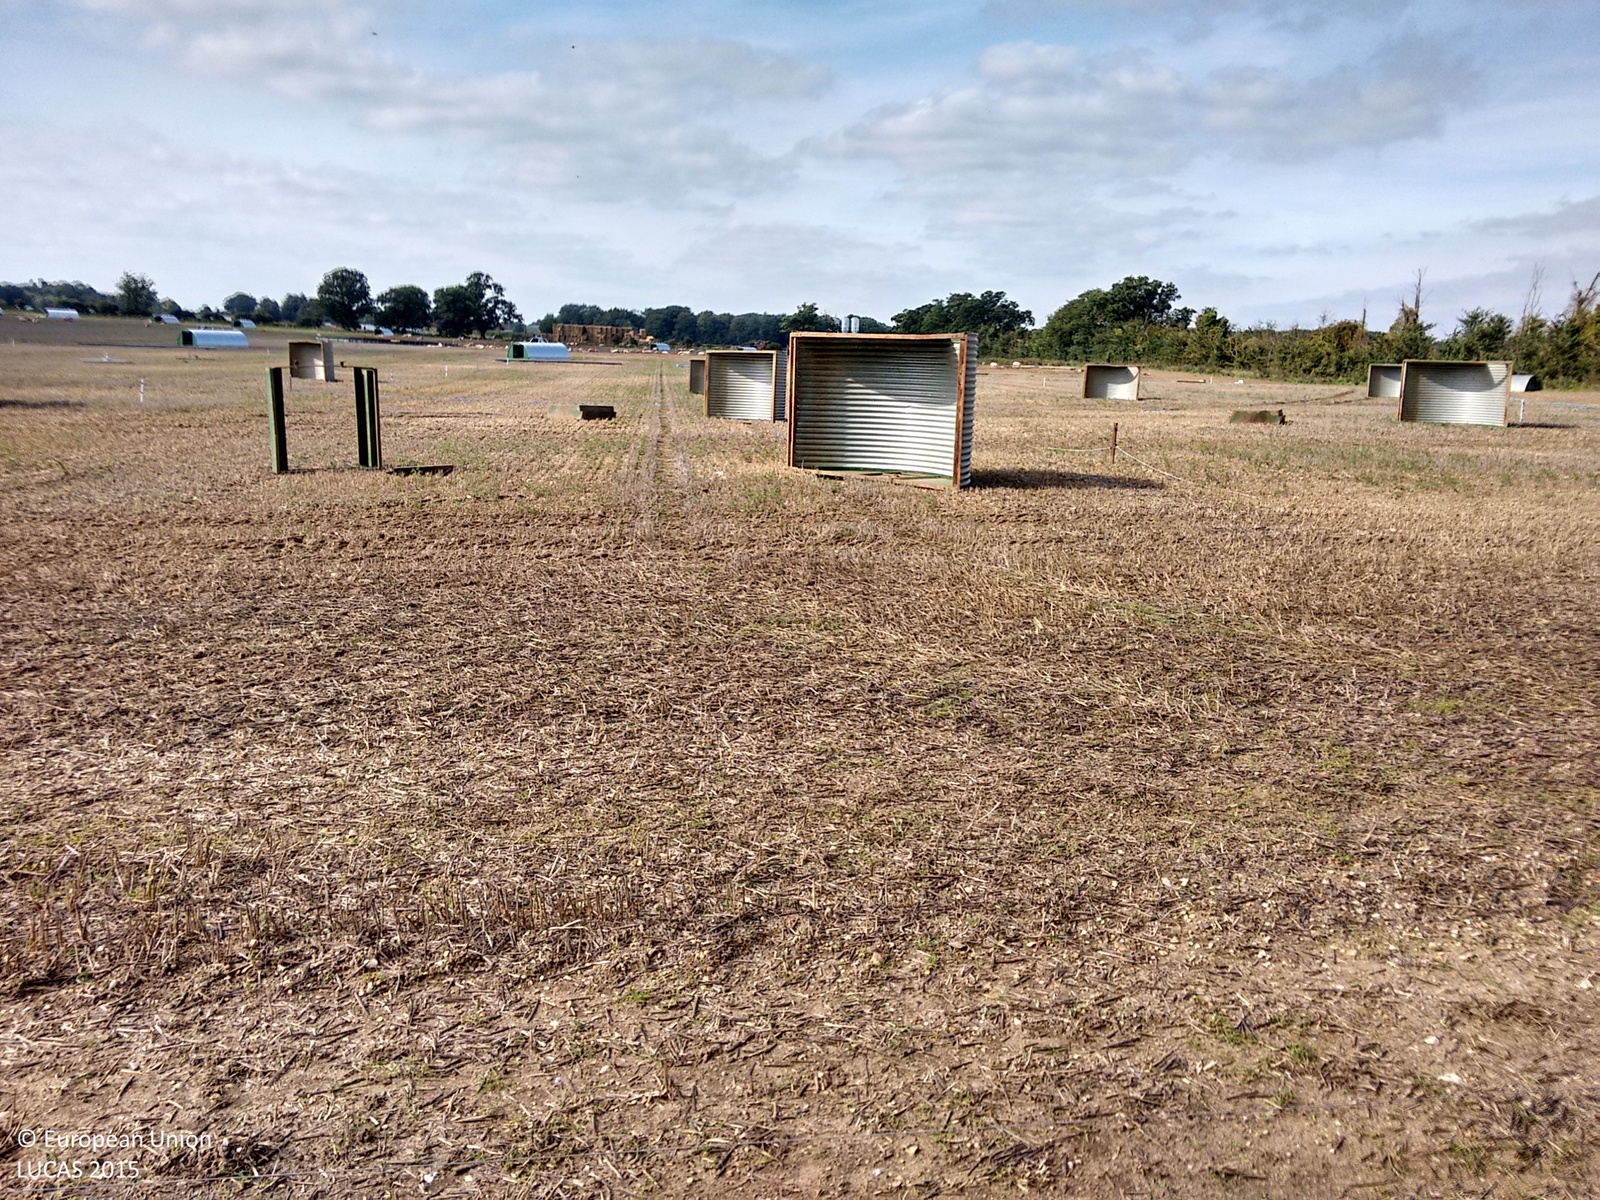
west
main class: Cropland
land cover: Common wheat
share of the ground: > 75 %
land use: Agriculture (excluding fallow land and kitchen gardens)
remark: Harvested field
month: September
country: GB
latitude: 52.4479
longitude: 0.9573
